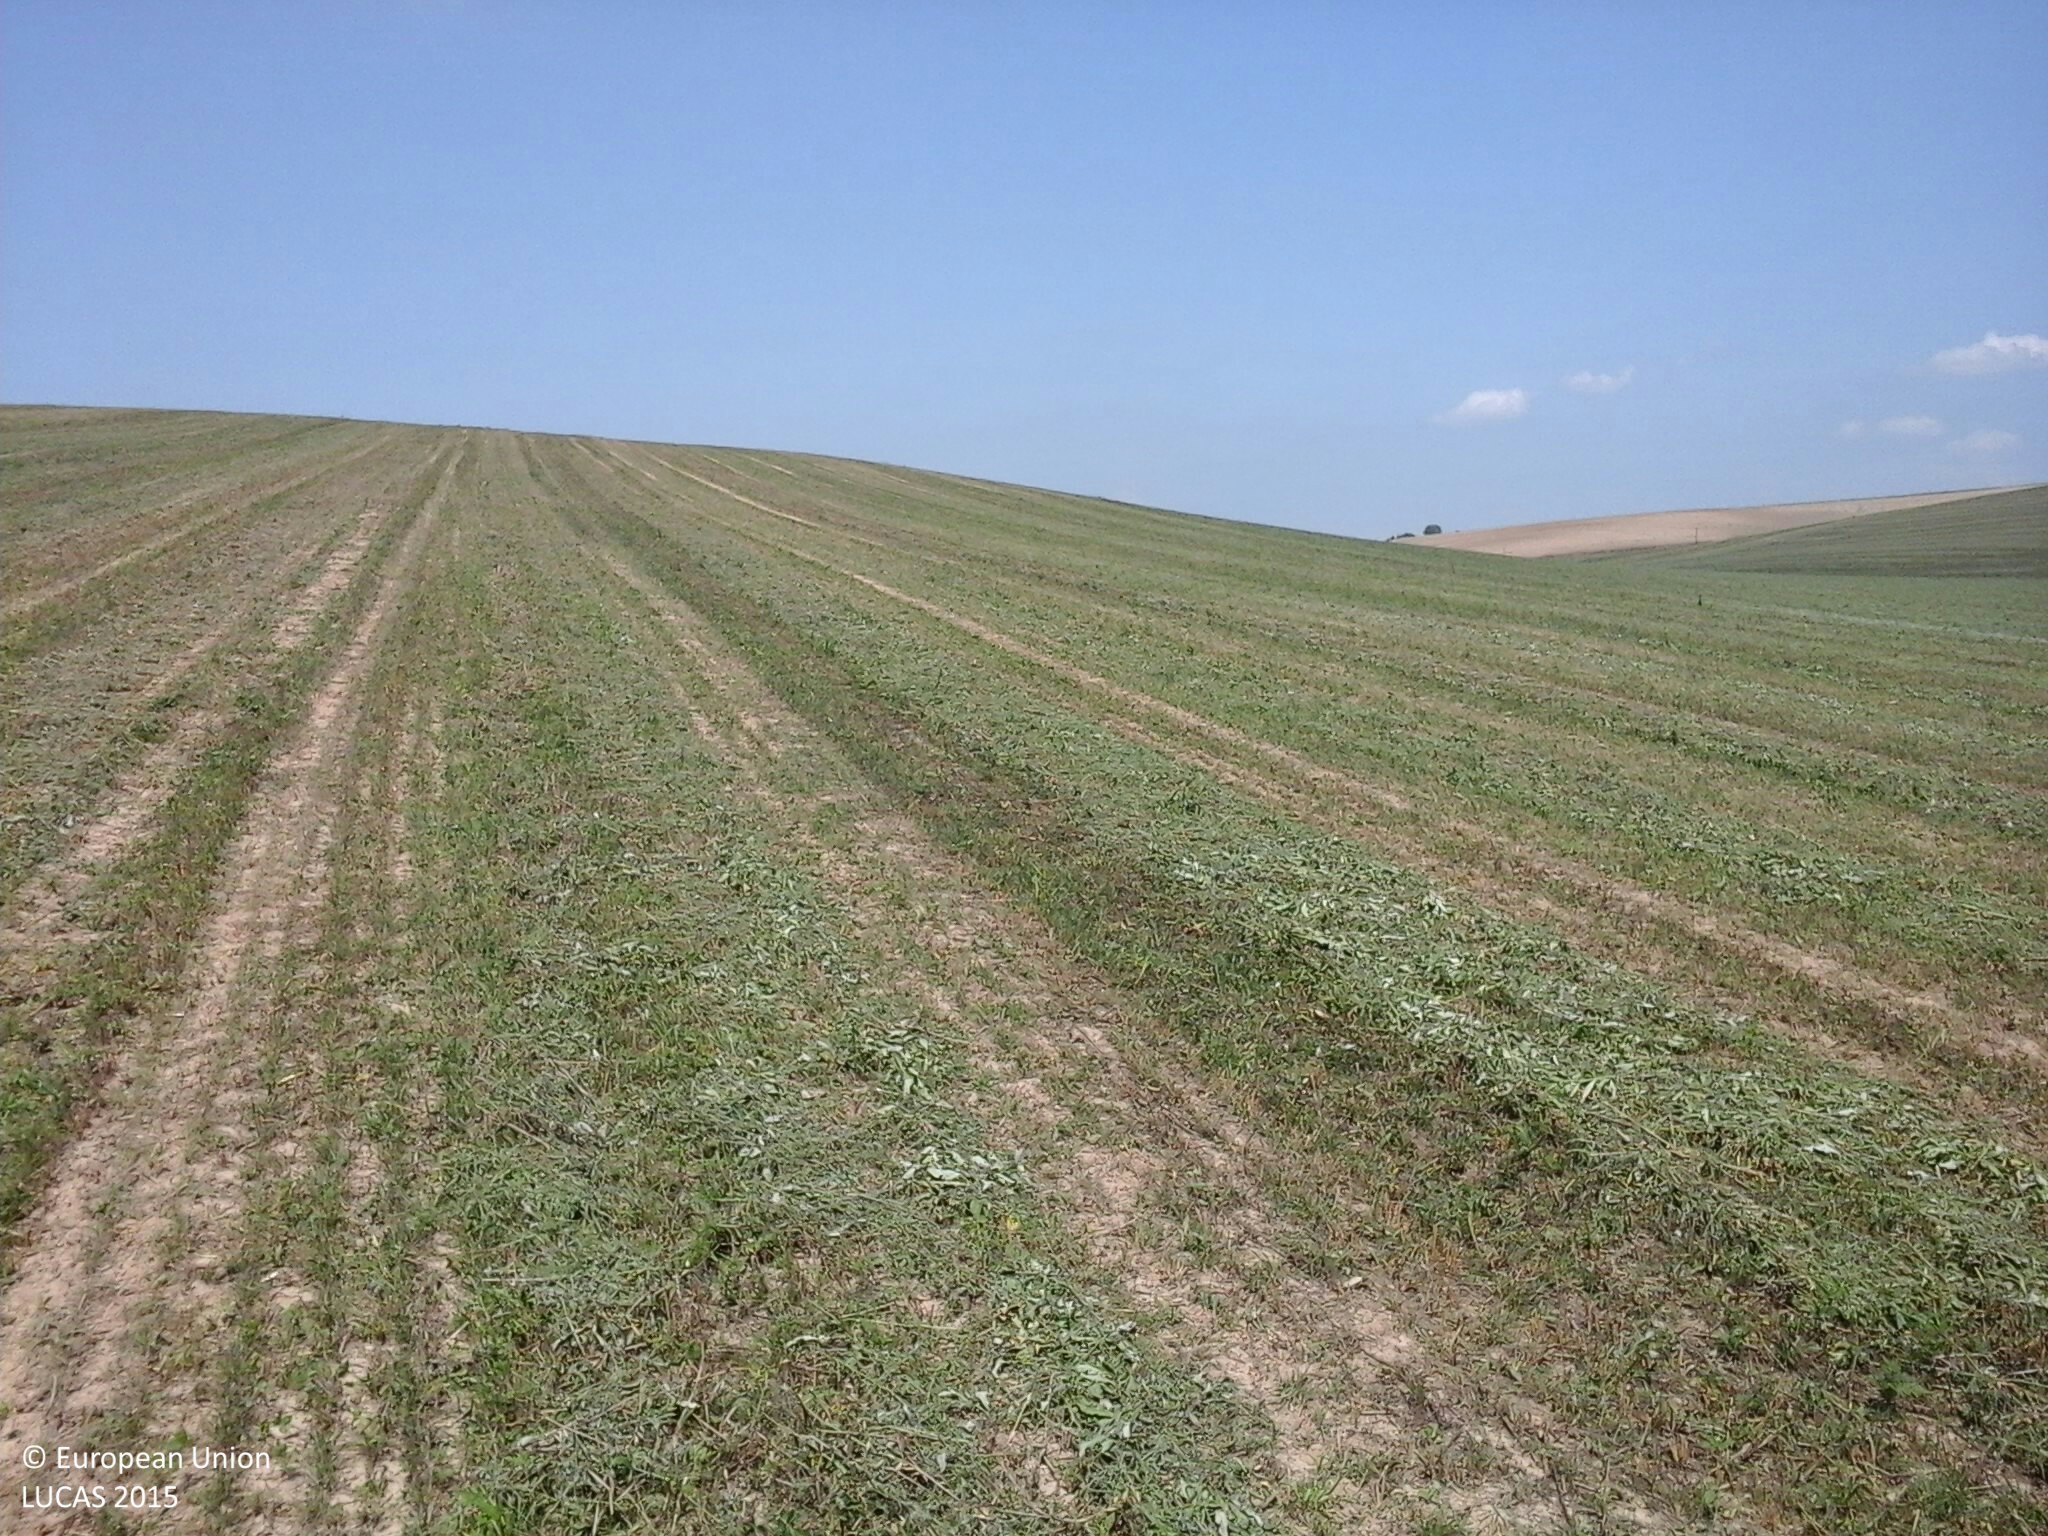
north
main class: Cropland
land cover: Lucerne
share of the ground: 25 - 50 %
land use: Agriculture (excluding fallow land and kitchen gardens)
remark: Harvested field
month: August
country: HU
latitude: 46.7206
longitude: 18.0020
